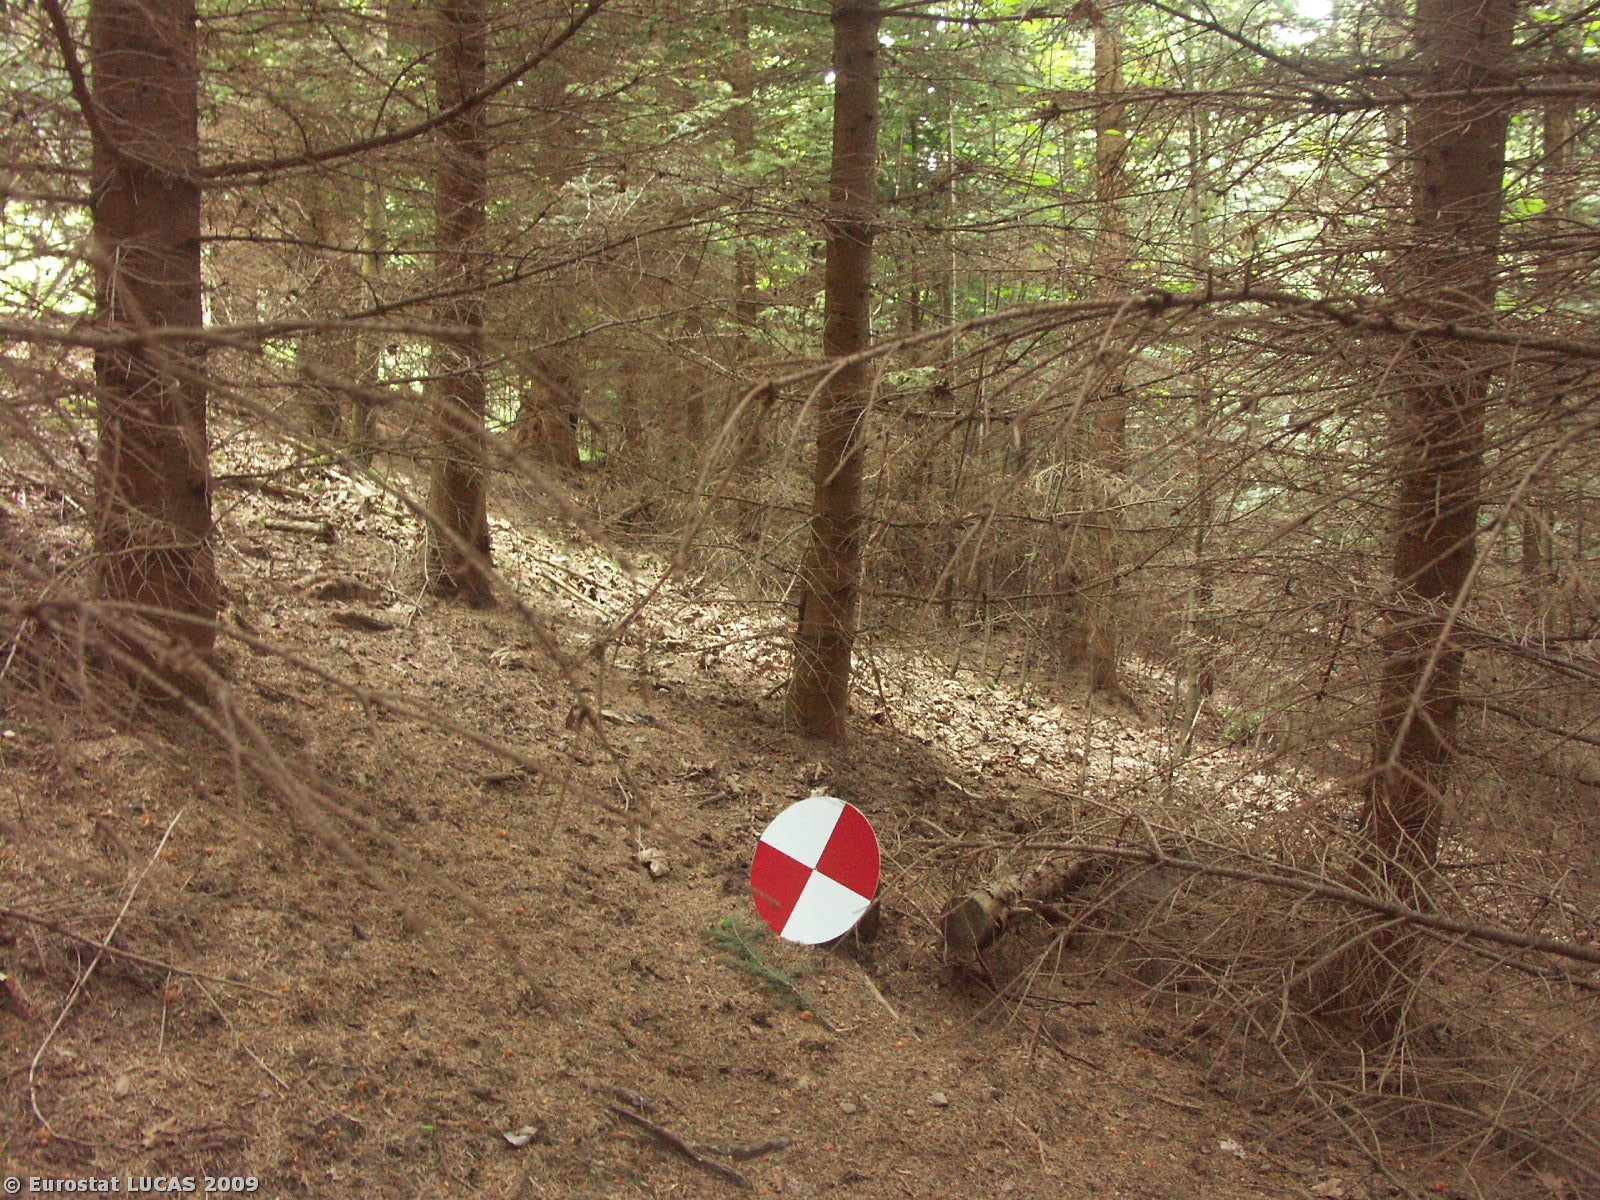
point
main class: Woodland
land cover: Coniferous woodland
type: hemiboreal forest and nemoral coniferous forest and mixed broadleaved-coniferous forest
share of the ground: > 75 %
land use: Forestry
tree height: > 5 m
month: May
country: CZ
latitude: 48.6860
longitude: 14.6059
